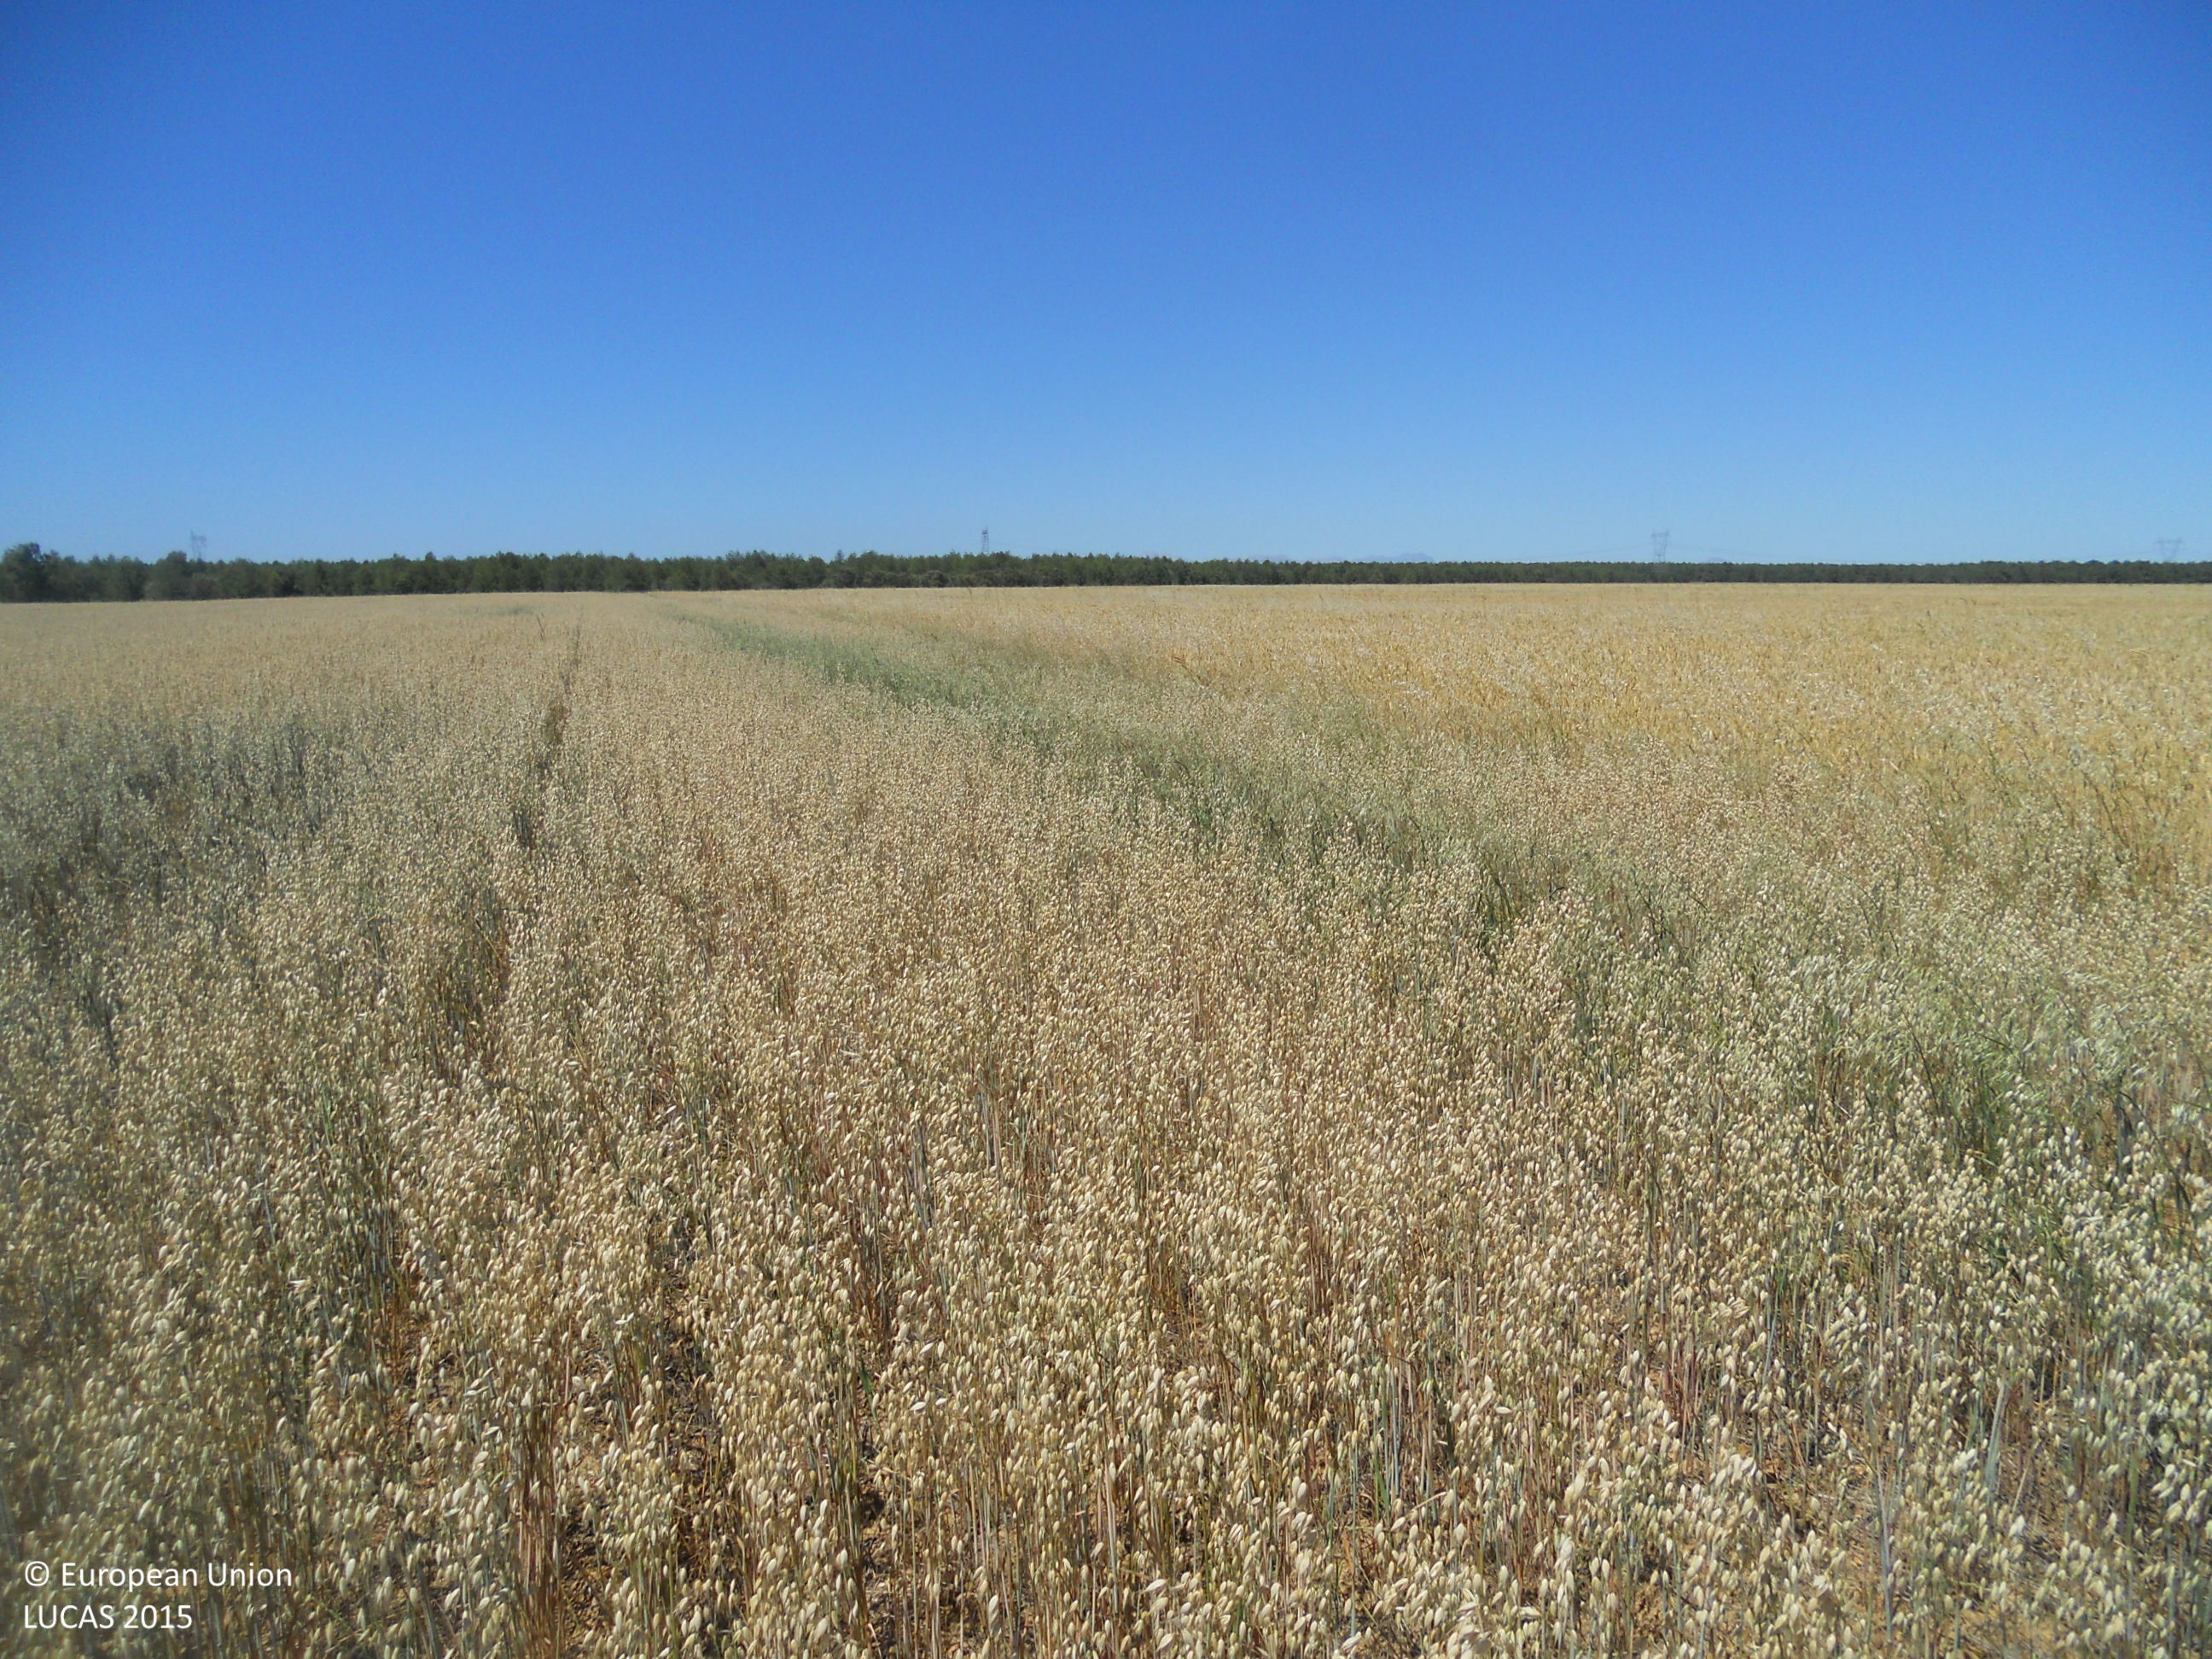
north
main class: Cropland
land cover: Oats
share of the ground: > 75 %
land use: Agriculture (excluding fallow land and kitchen gardens)
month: June
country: ES
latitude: 42.4323
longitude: -4.8497
